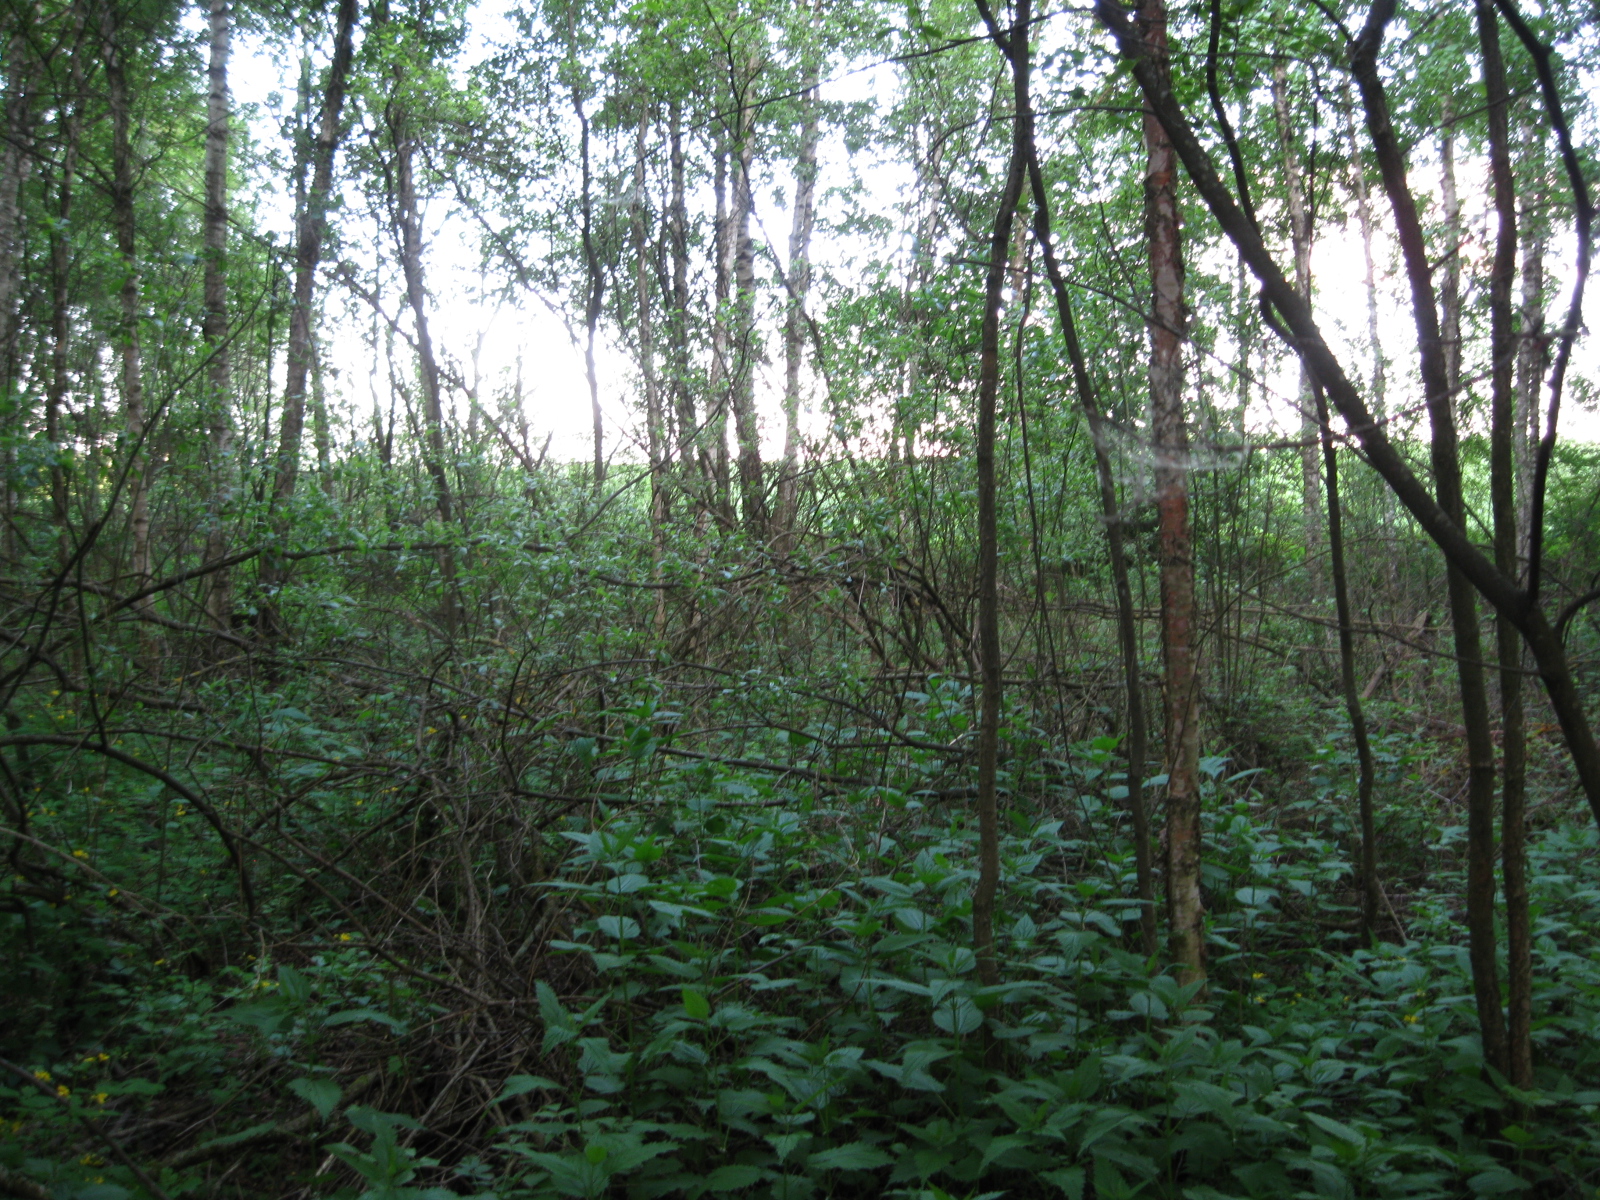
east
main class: Woodland
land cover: Broadleaved woodland
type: non-riverine alder, birch or aspen forest
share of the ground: > 75 %
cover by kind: broadleaved forest trees 85 %, herbaceous plants 15 %
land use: Semi-natural and natural areas not in use
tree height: > 5 m
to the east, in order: Broadleaved woodland; Common wheat
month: May
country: LT
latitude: 55.9431
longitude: 24.8201
